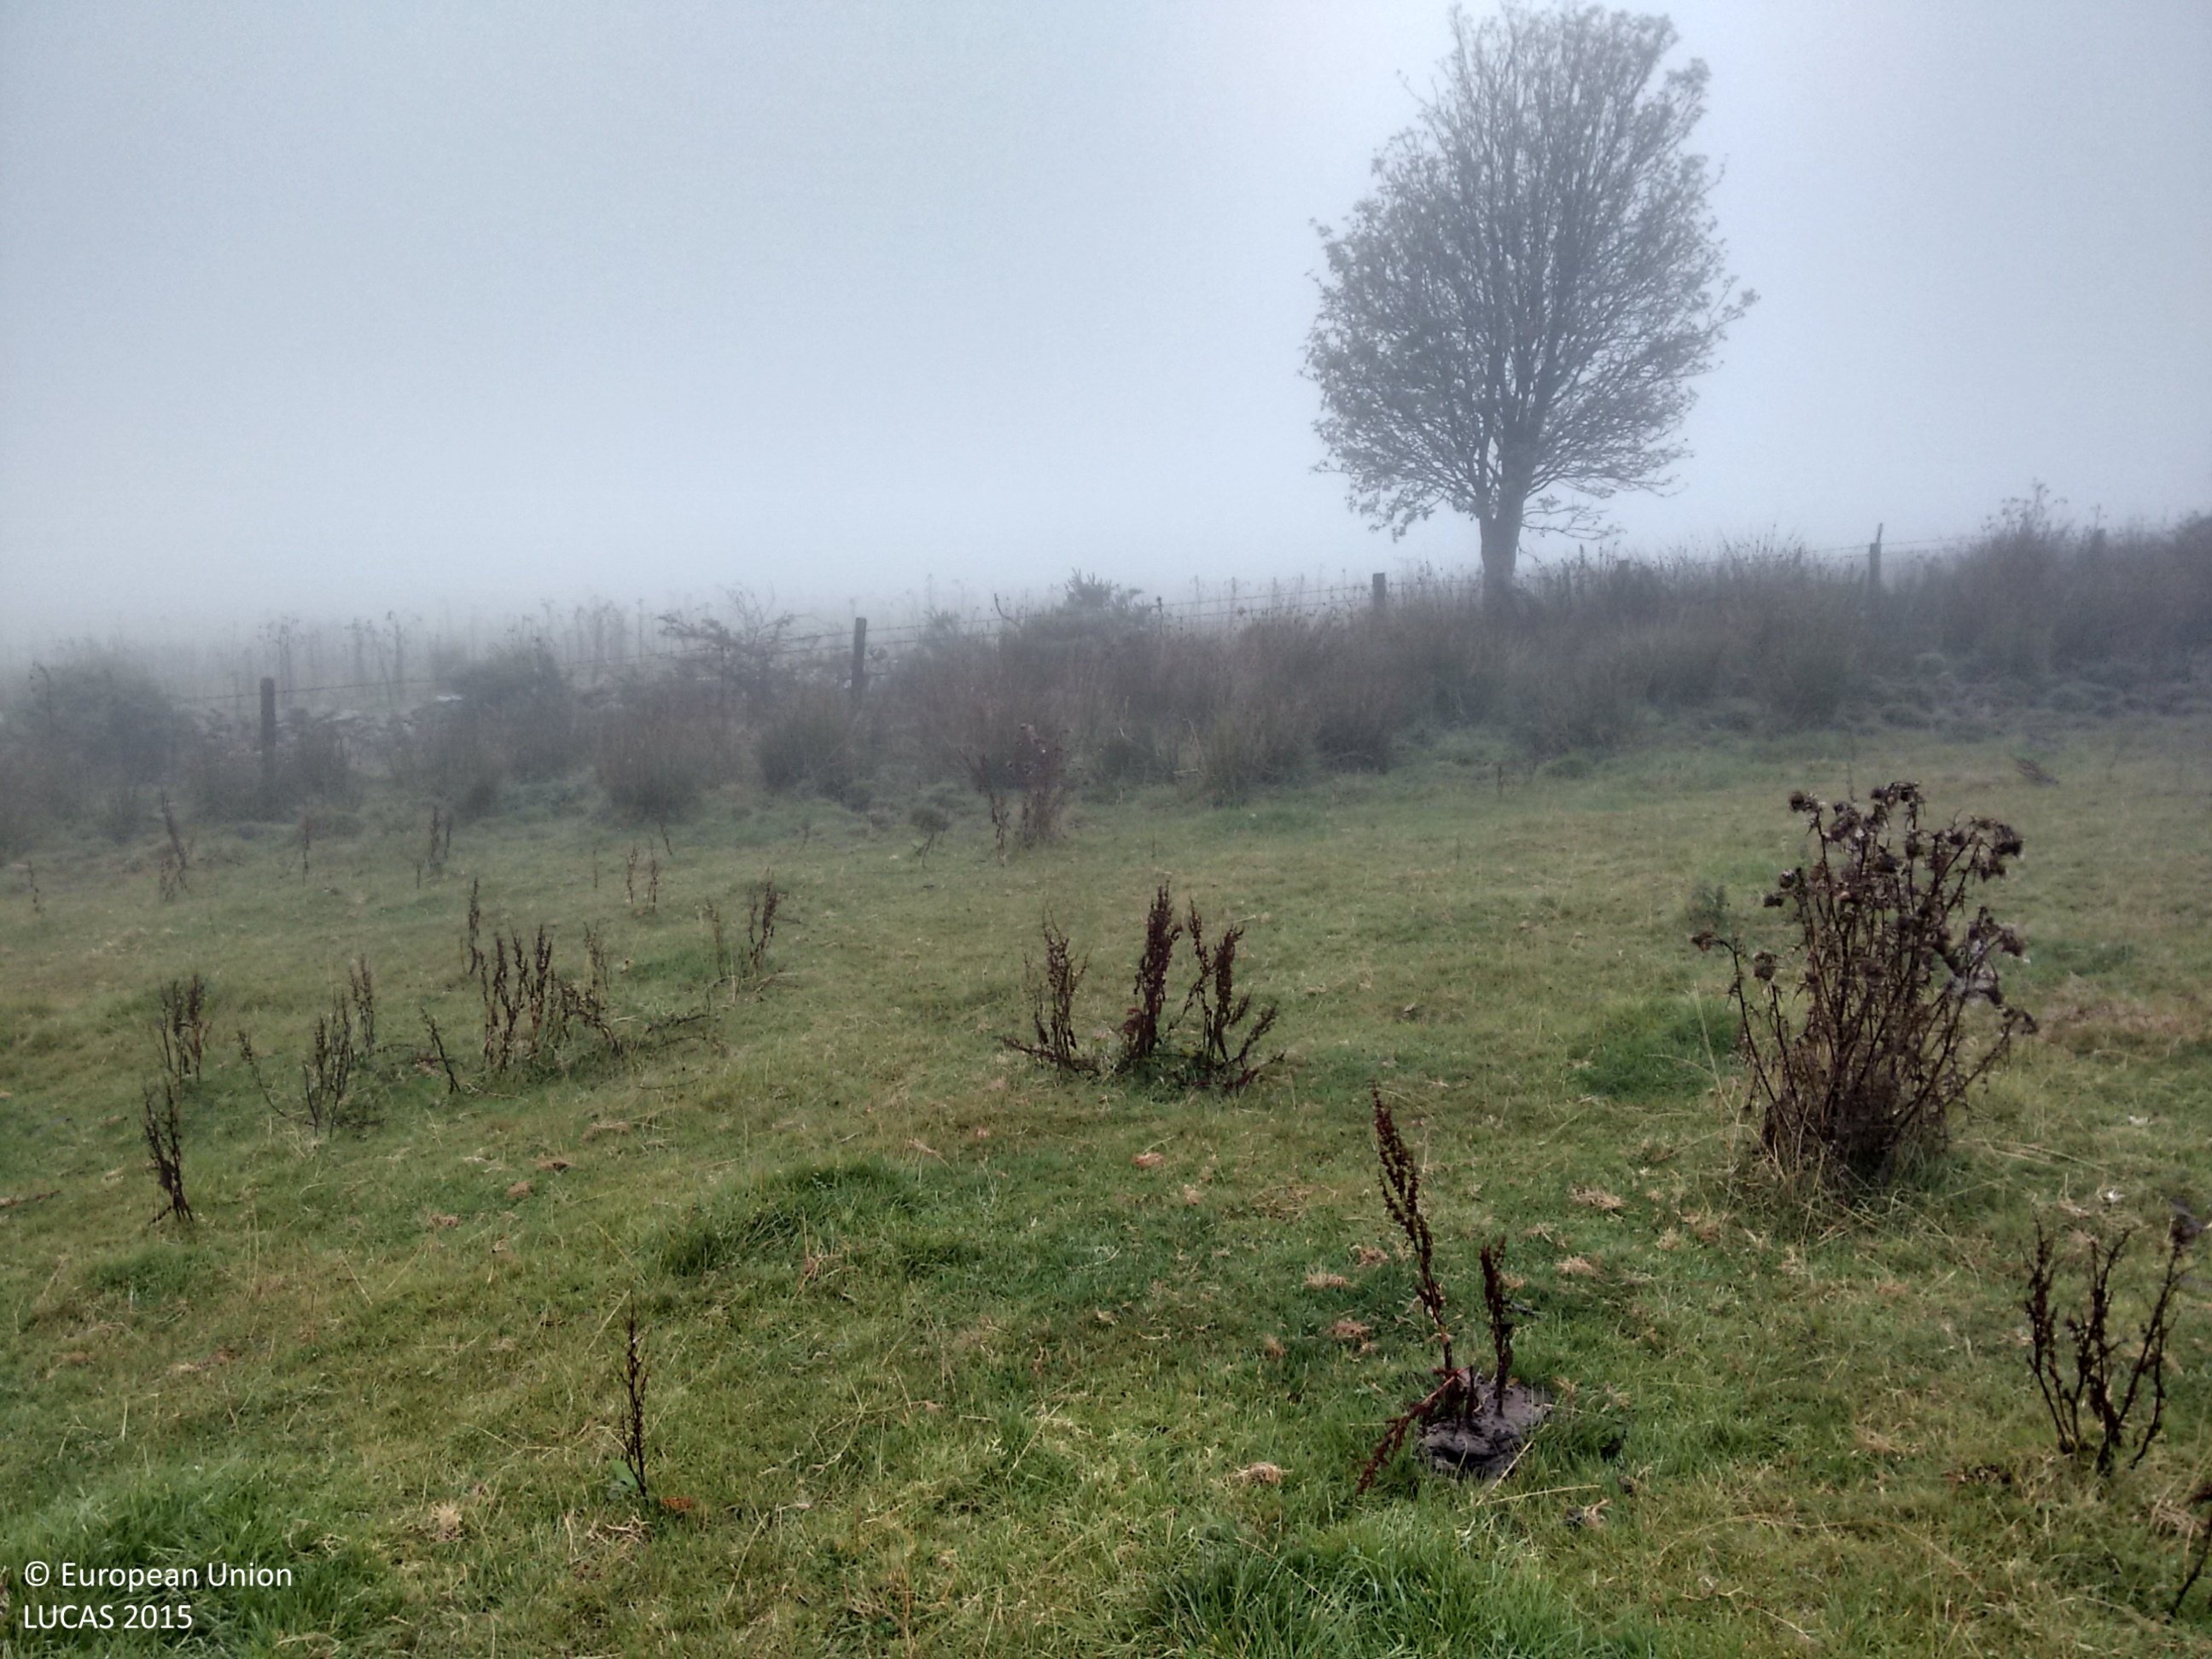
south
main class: Grassland
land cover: Grassland without tree/shrub cover
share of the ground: > 75 %
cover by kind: herbaceous plants 100 %
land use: Agriculture (excluding fallow land and kitchen gardens)
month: September
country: GB
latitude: 52.5778
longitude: -2.9269
